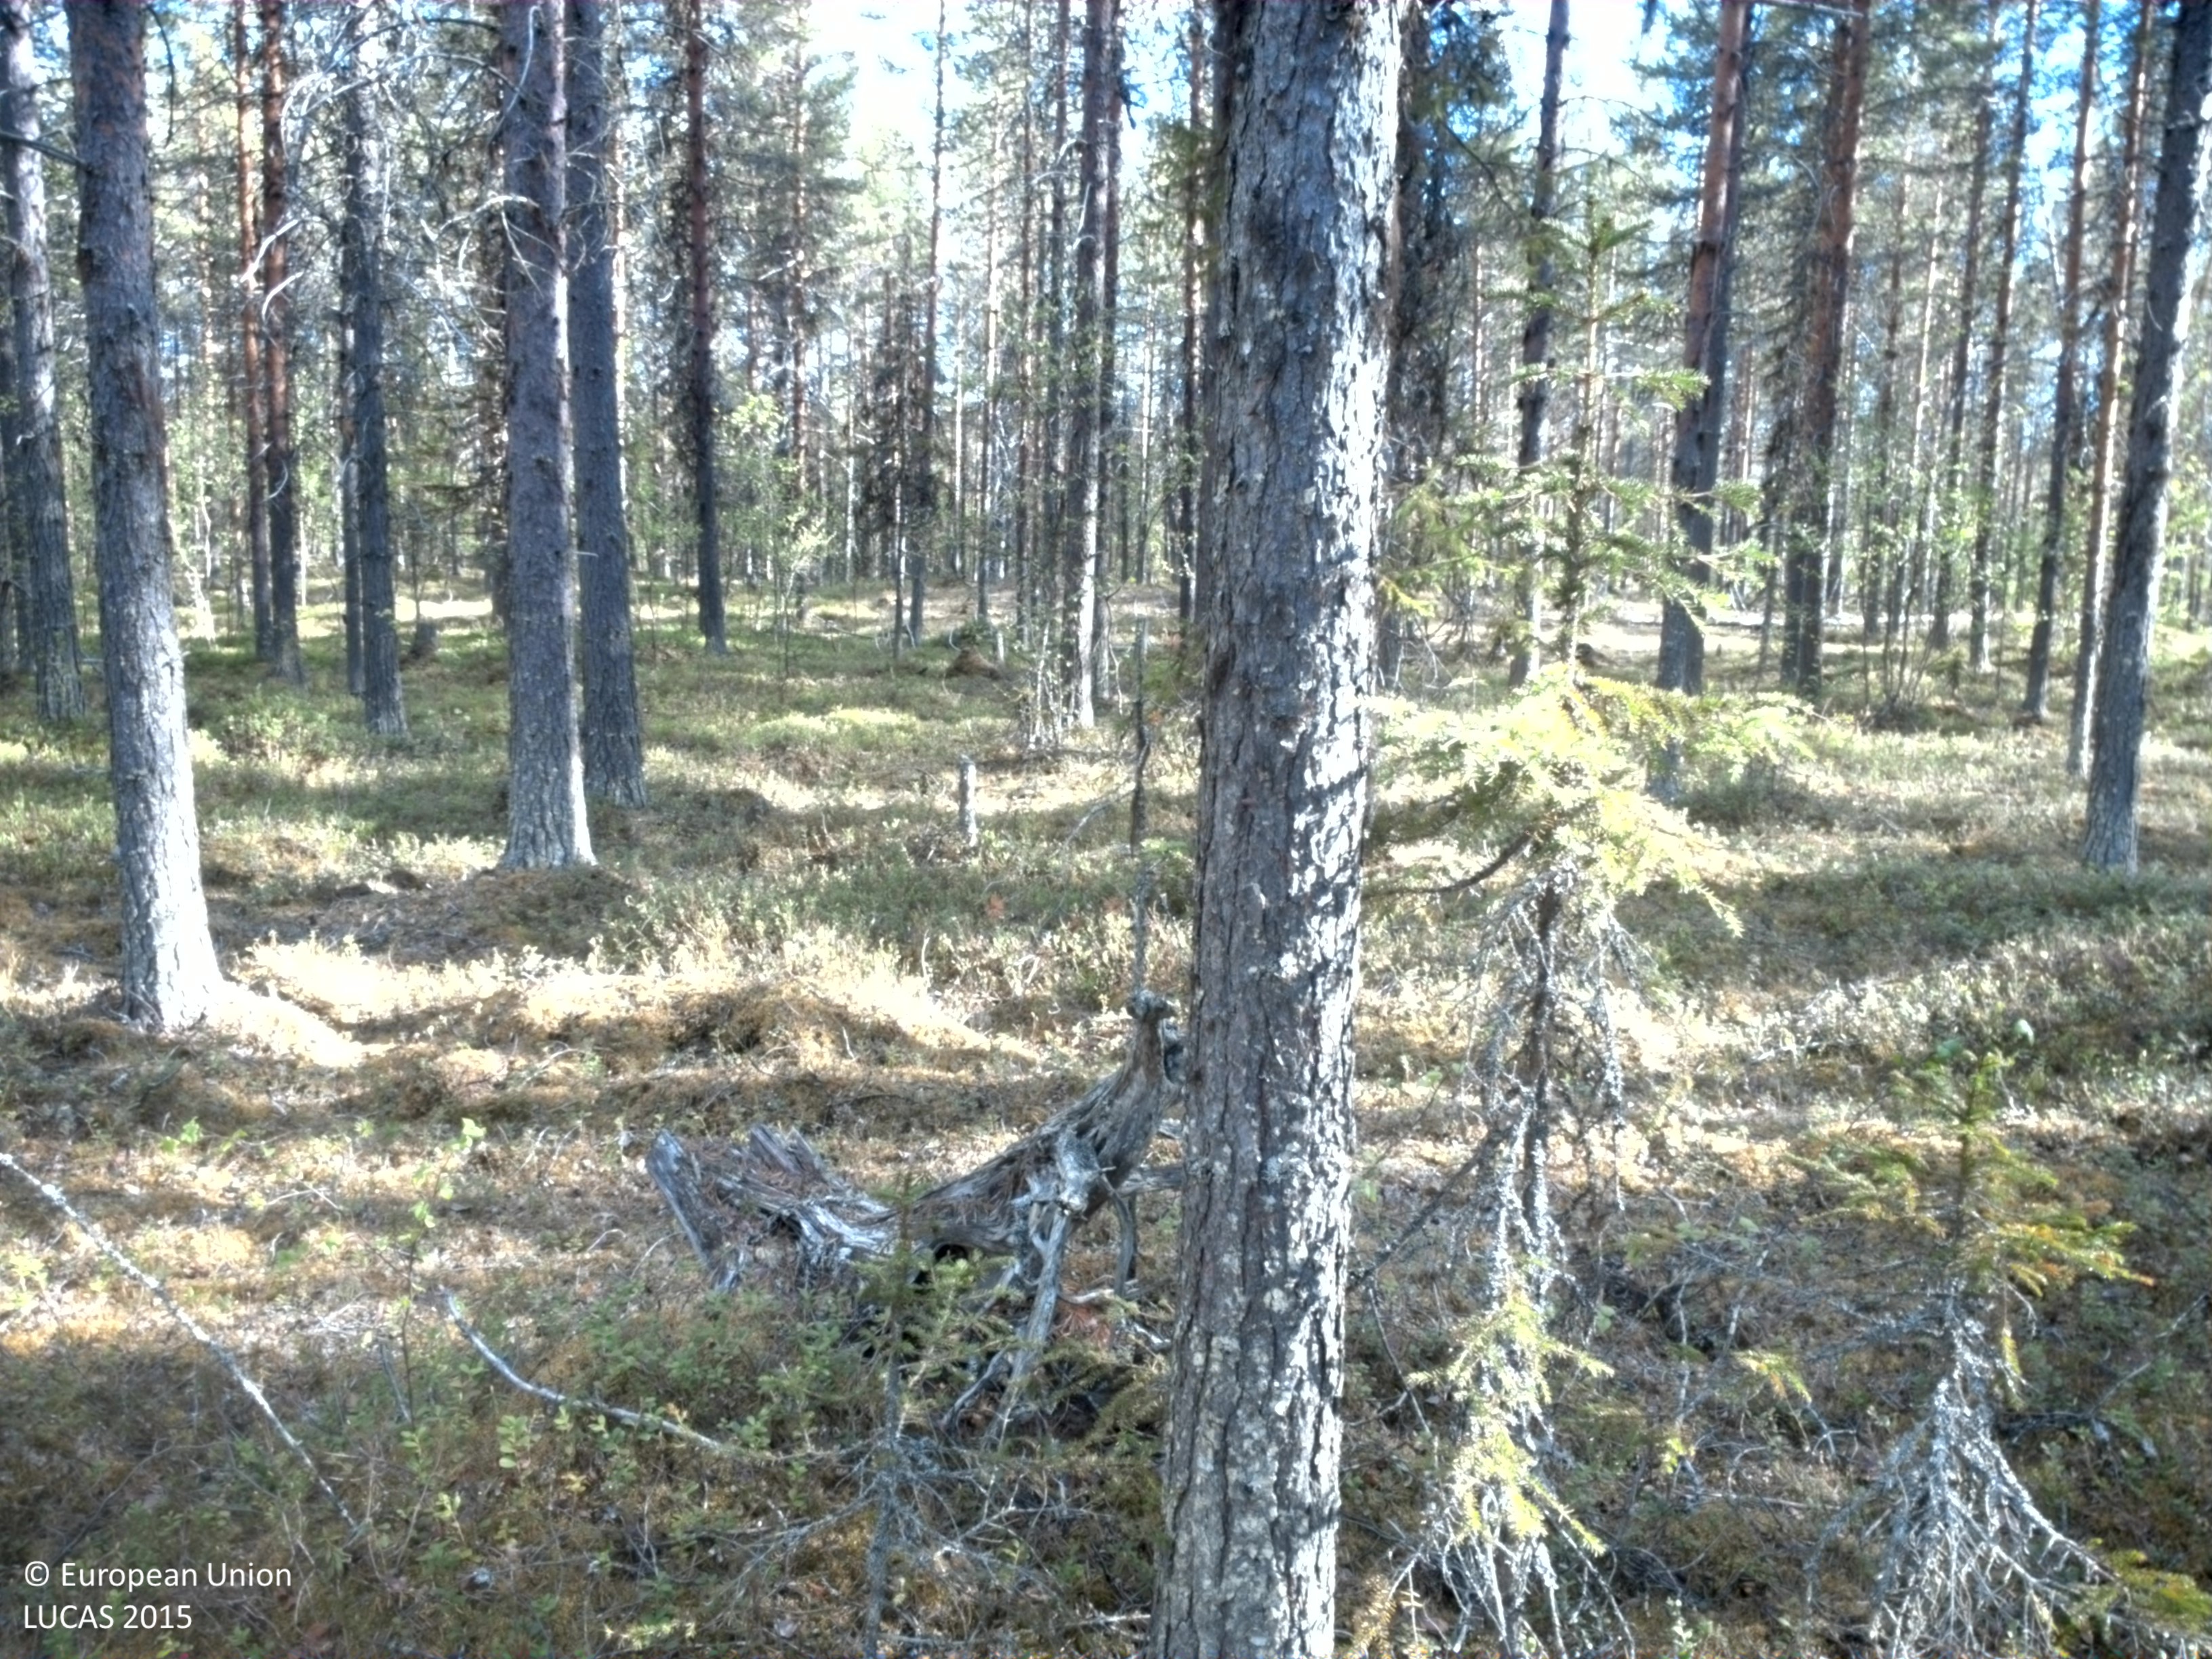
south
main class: Woodland
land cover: Pine dominated coniferous woodland
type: boreal forest
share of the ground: 25 - 50 %
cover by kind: shrubs 55 %, coniferous forest trees 40 %, broadleaved forest trees 5 %
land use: Forestry
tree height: > 5 m
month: June
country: SE
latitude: 65.8631
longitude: 19.4923
